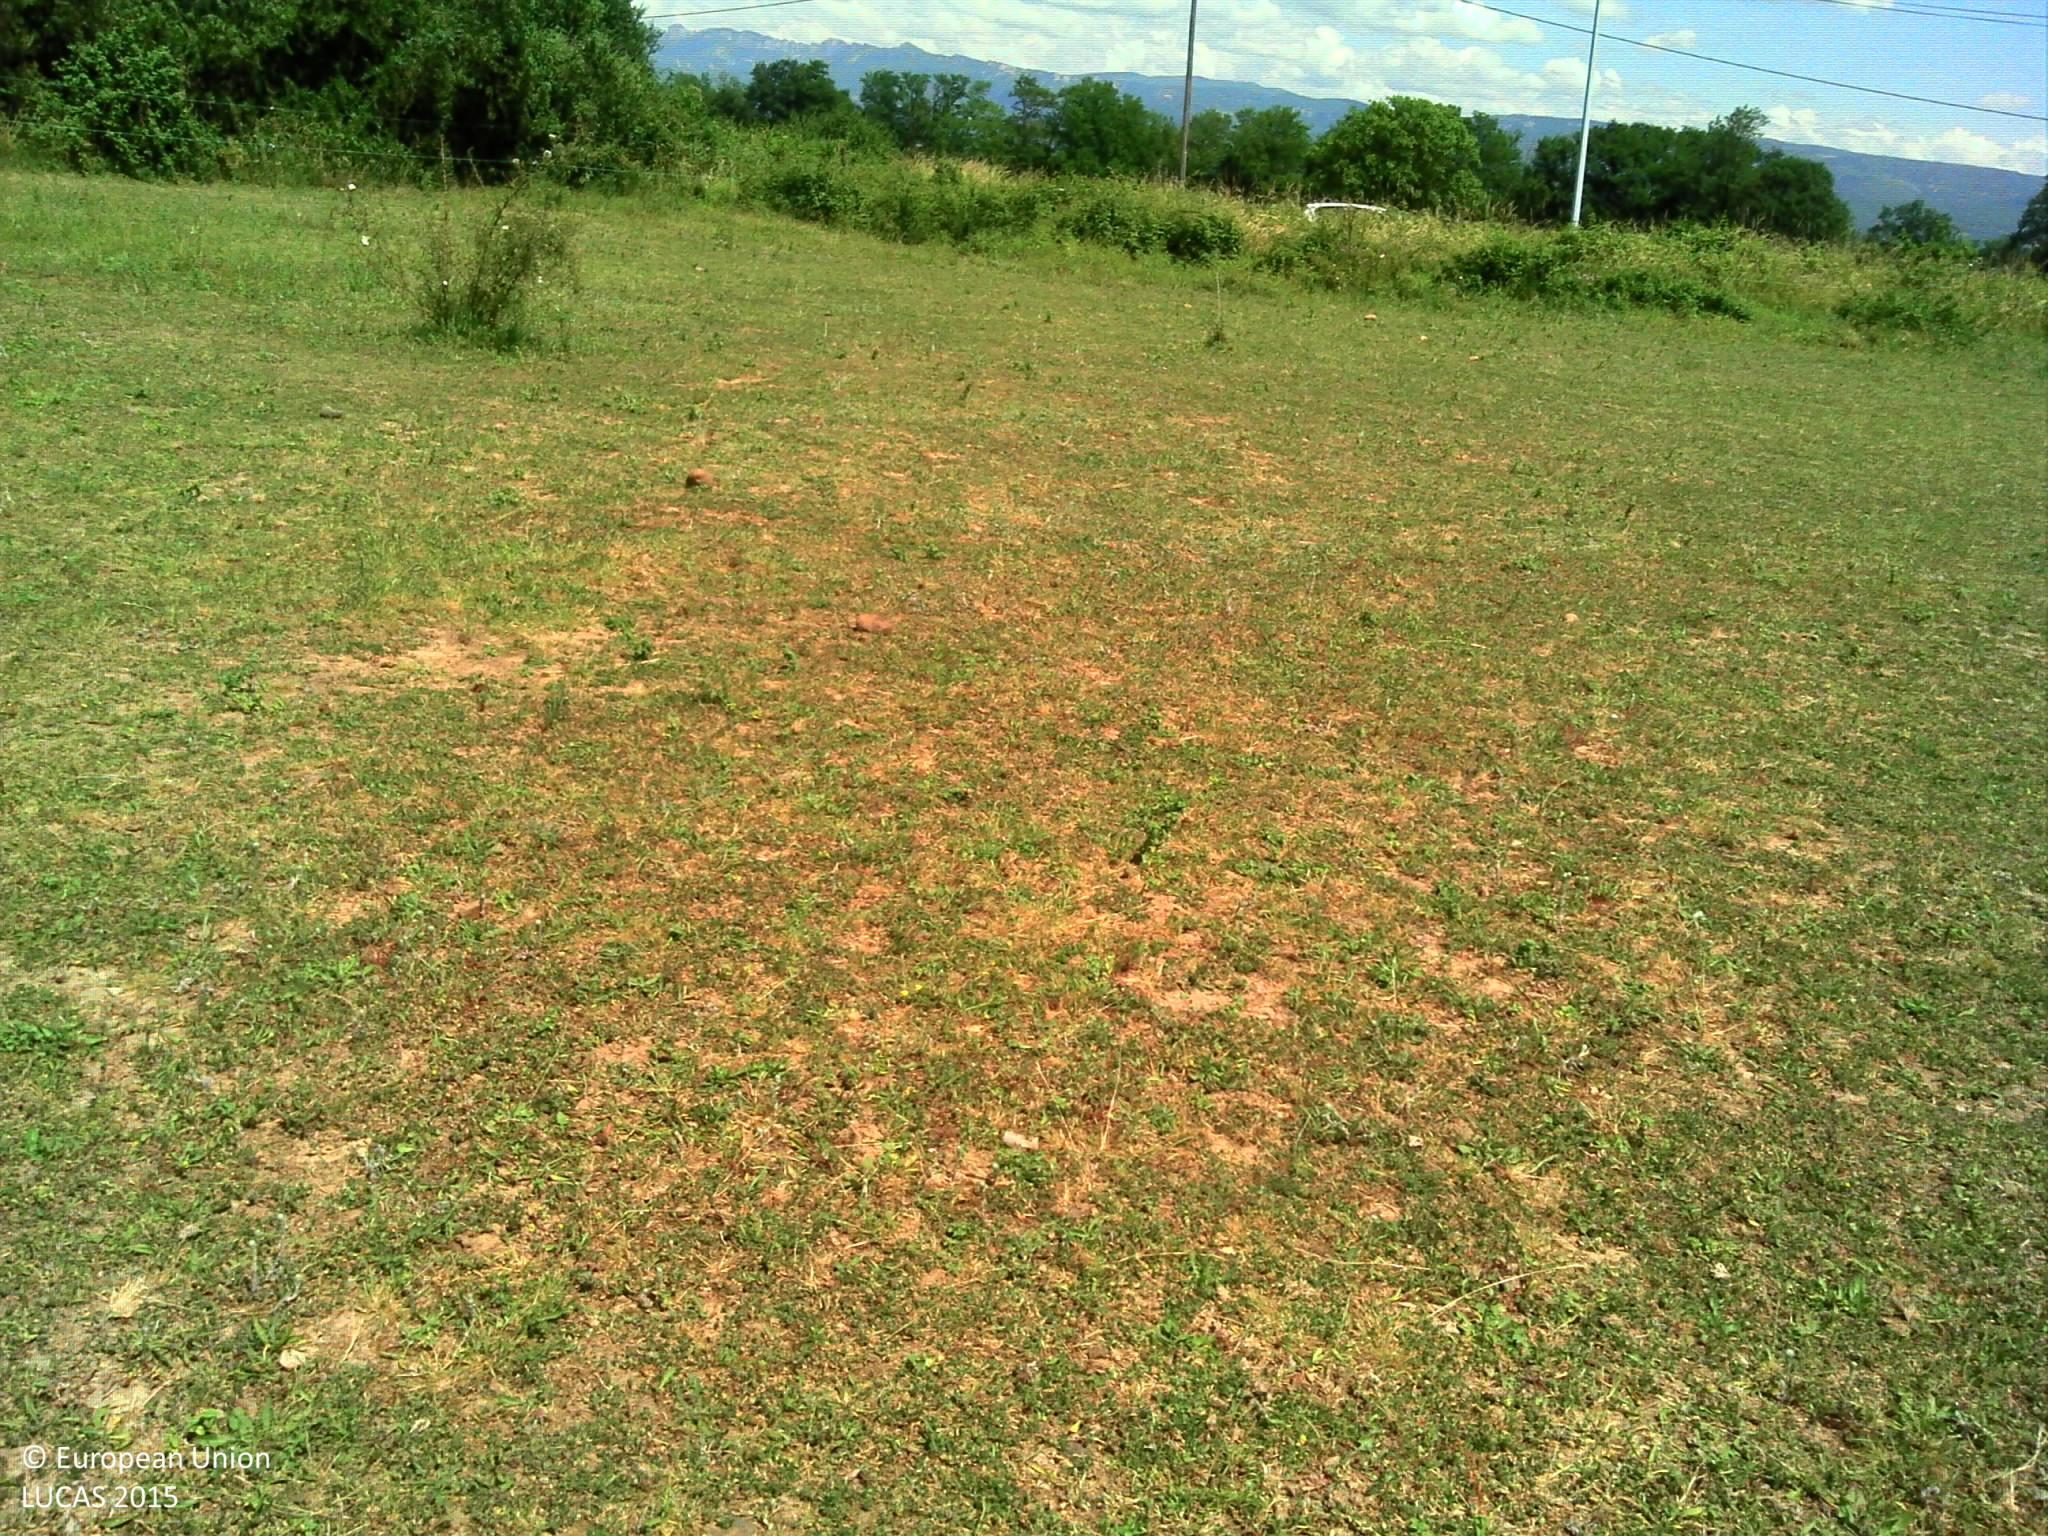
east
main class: Grassland
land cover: Grassland without tree/shrub cover
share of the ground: > 75 %
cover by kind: herbaceous plants 100 %
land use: Agriculture (excluding fallow land and kitchen gardens)
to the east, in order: Grassland without tree/shrub cover; Fences; Abandoned hedges; Dry stone walls; Grassland without tree/shrub cover; Electric lines; Paved roads, cycling and walking lanes; Grass margins; Common wheat; Electric lines; Common wheat; Broadleaved woodland
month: May
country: FR
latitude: 44.8770
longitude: 4.9297
